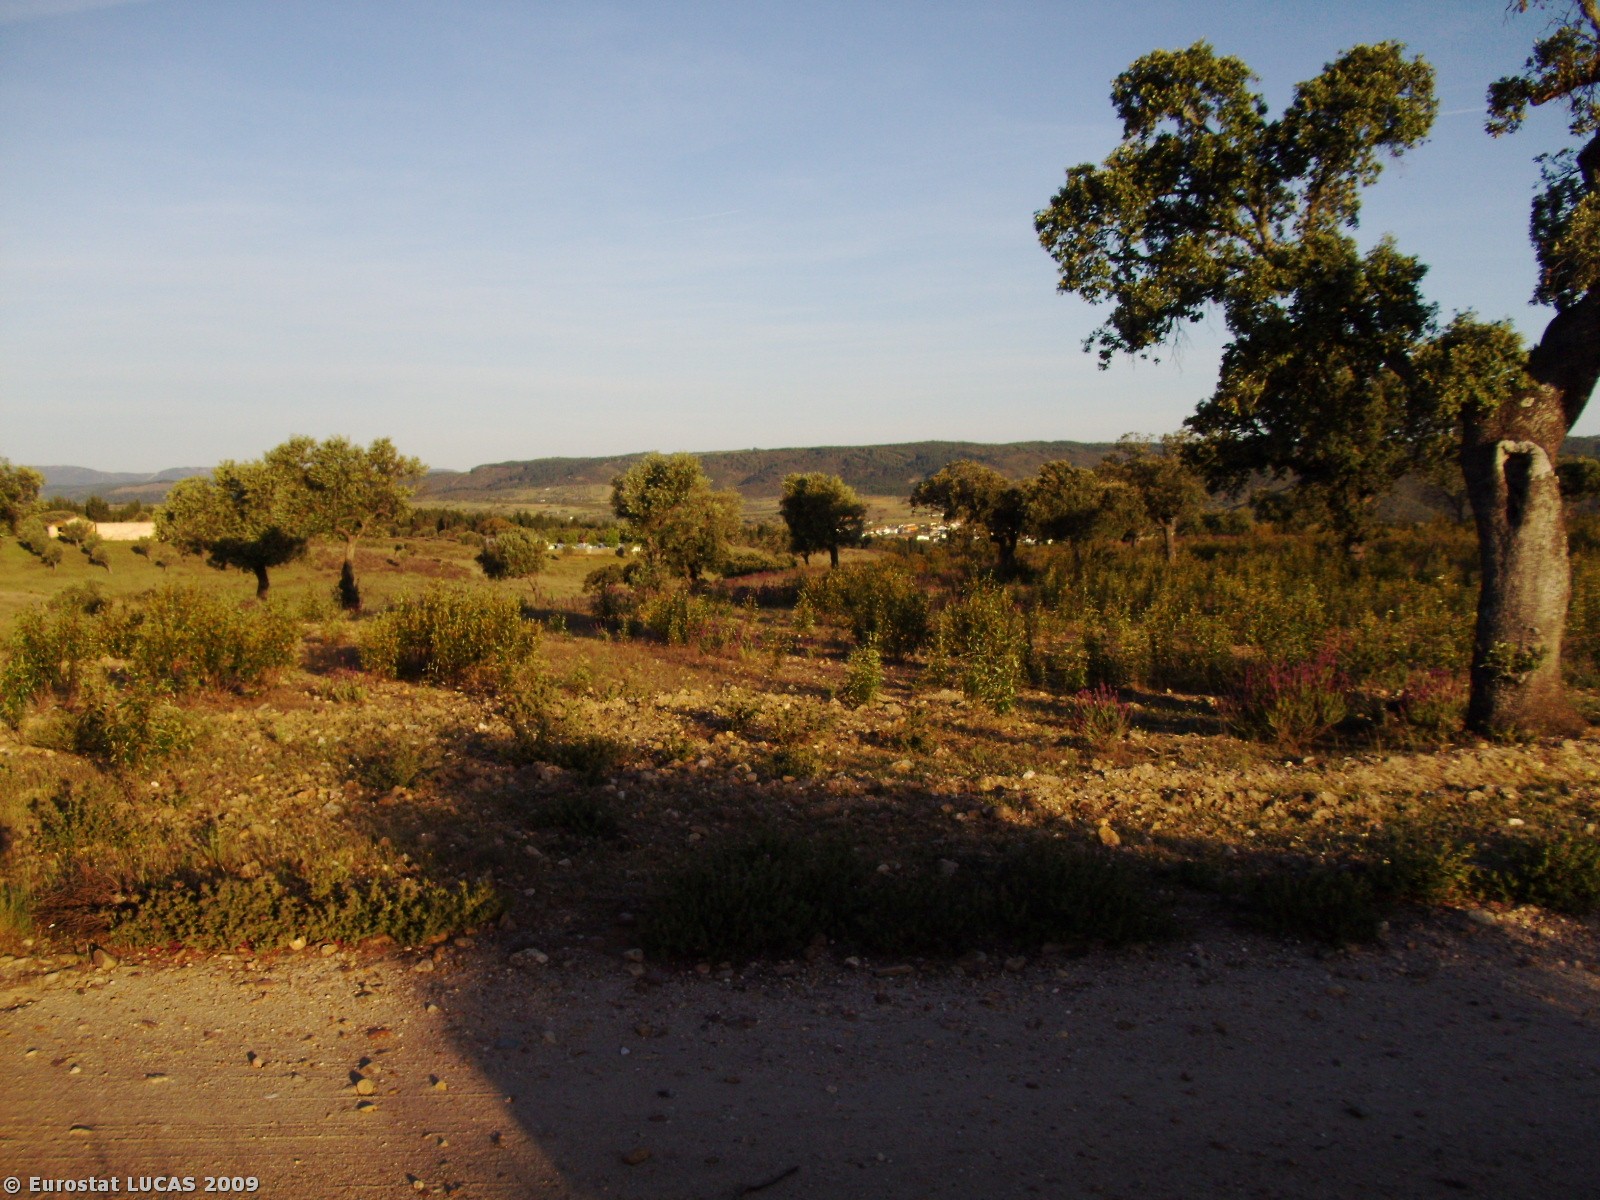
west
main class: Woodland
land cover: Broadleaved woodland
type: broadleaved evergreen forest
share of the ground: 10 - 25 %
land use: Forestry
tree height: > 5 m
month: May
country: PT
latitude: 39.7121
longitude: -7.5125
